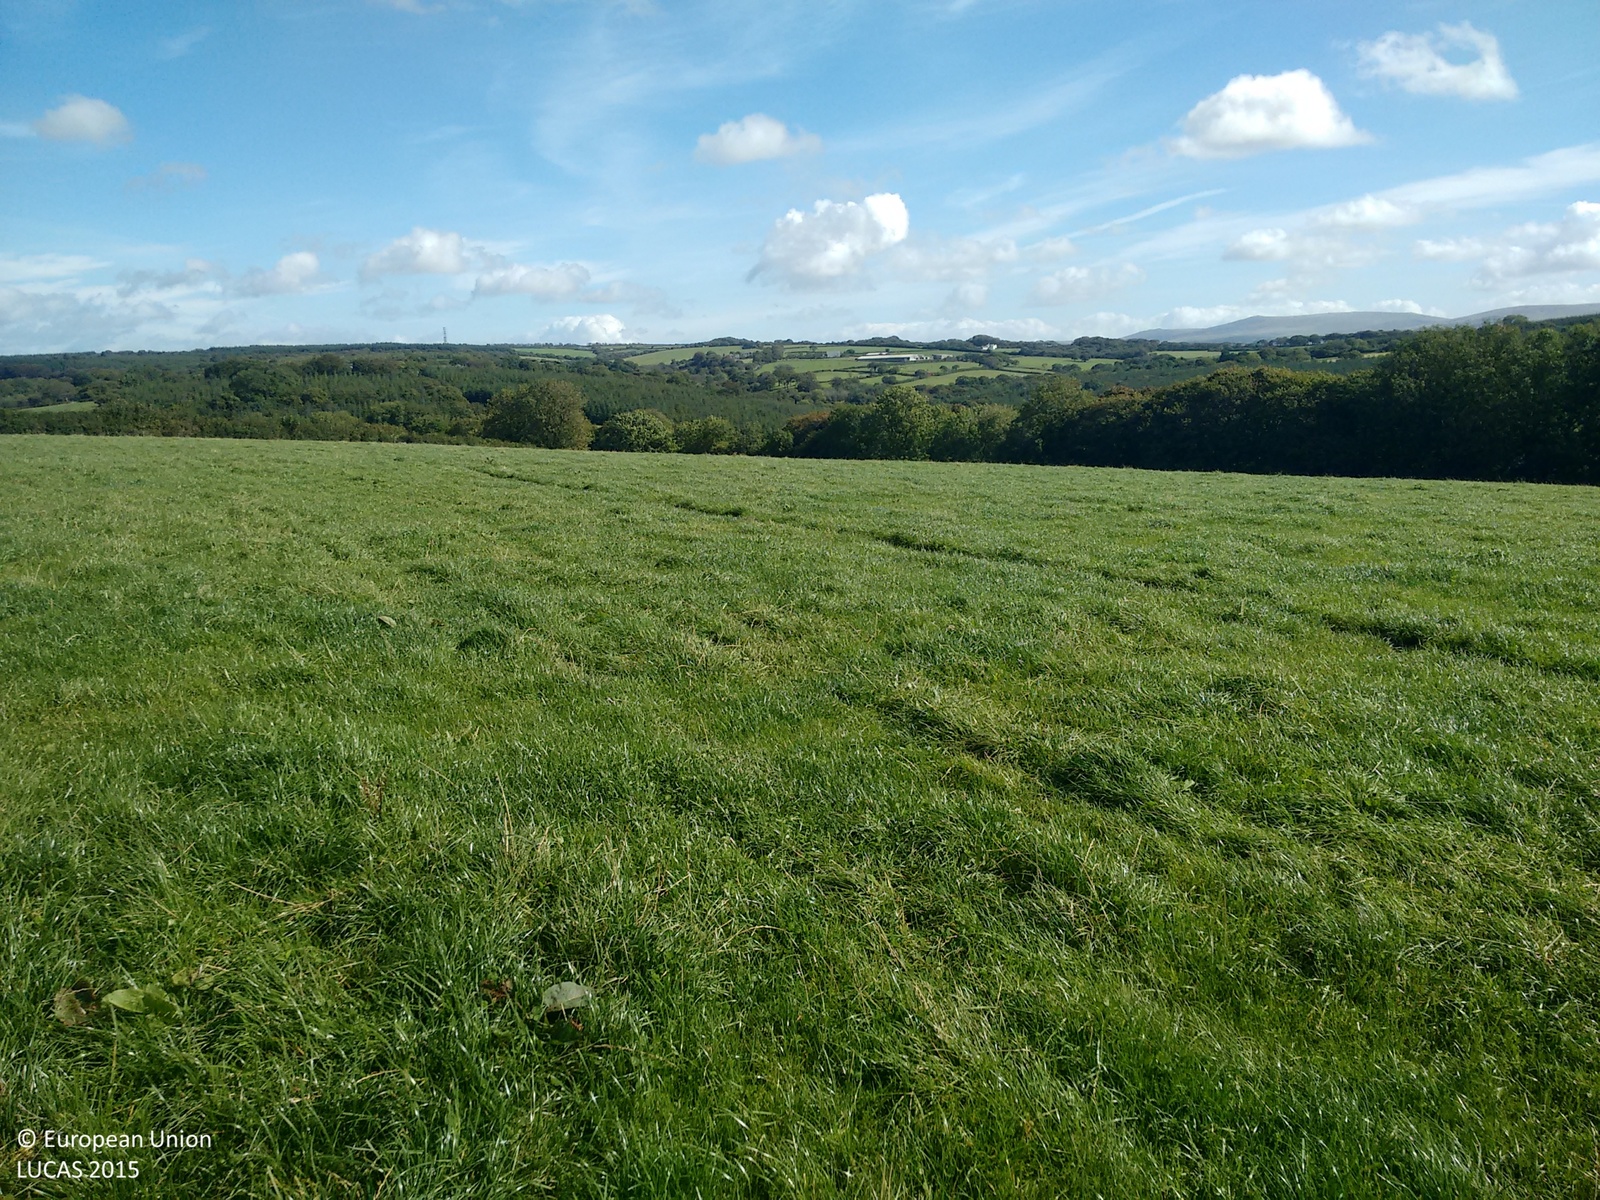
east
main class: Grassland
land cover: Grassland without tree/shrub cover
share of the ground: > 75 %
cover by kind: herbaceous plants 100 %
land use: Agriculture (excluding fallow land and kitchen gardens)
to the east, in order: Grassland without tree/shrub cover; Fences; Broadleaved woodland
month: September
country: GB
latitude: 50.7330
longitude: -4.1956
